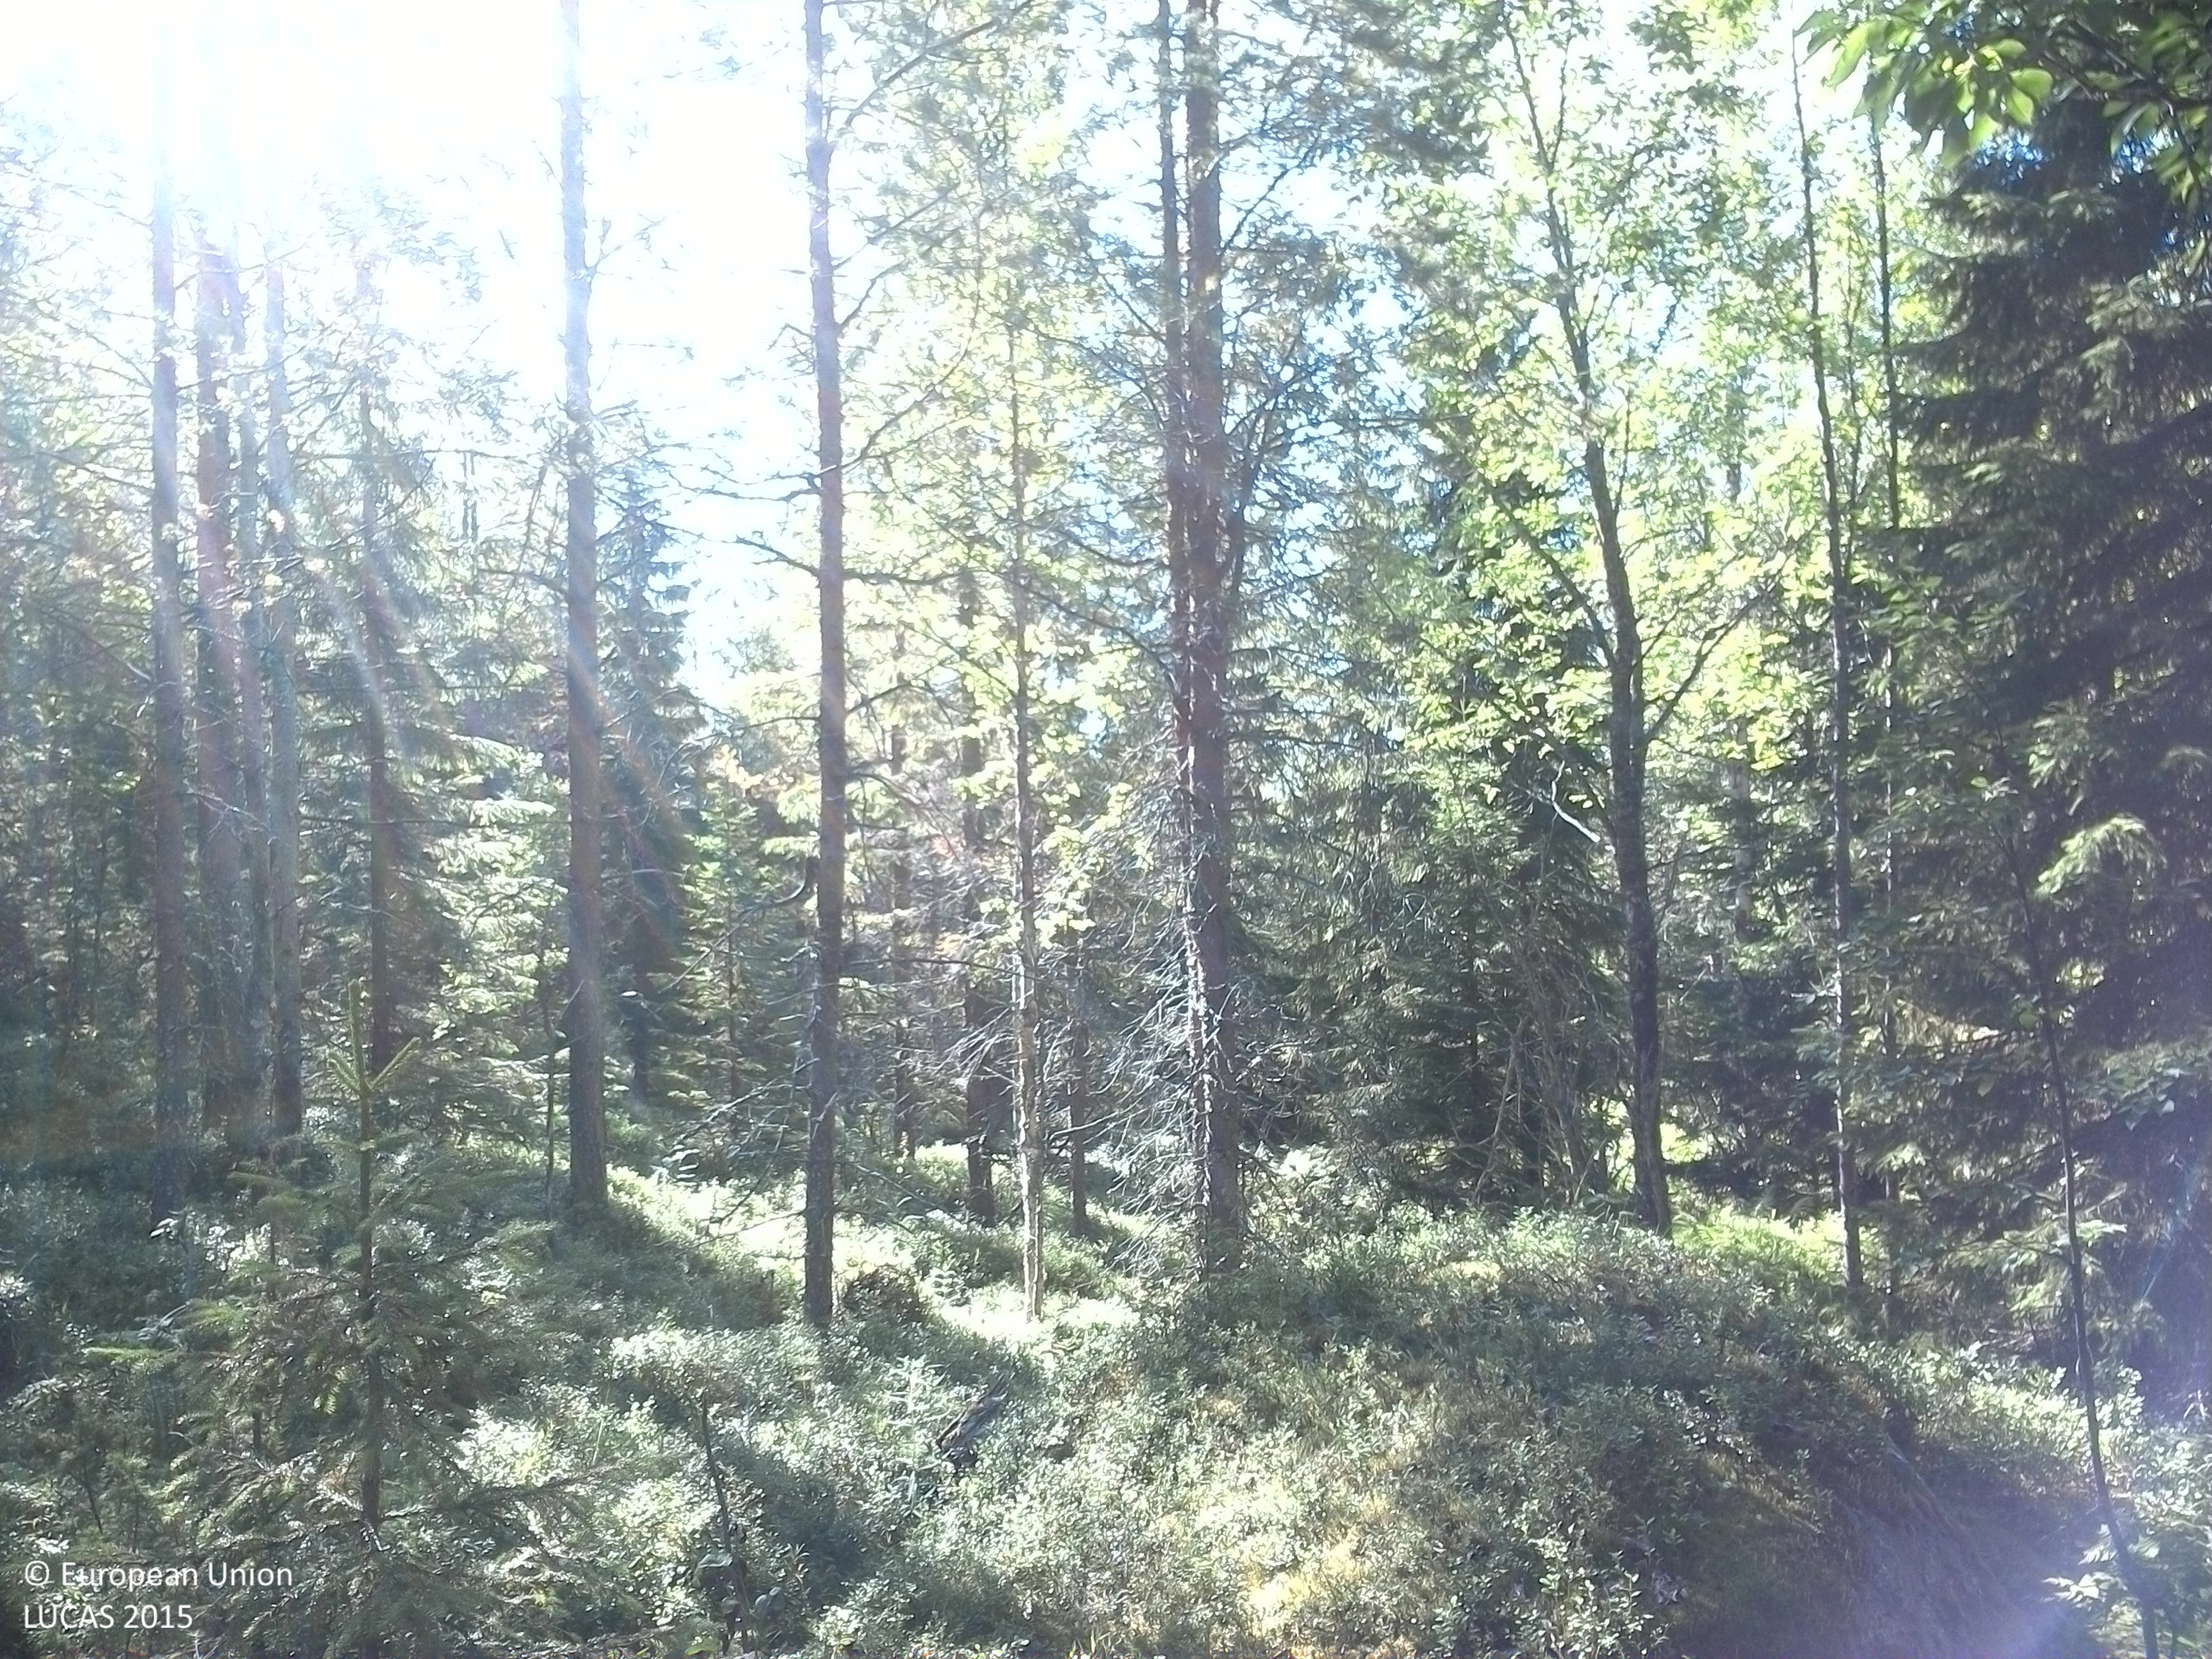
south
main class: Woodland
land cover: Pine dominated mixed woodland
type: boreal forest
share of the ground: 50 - 75 %
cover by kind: coniferous forest trees 35 %, shrubs 35 %, broadleaved forest trees 30 %
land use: Forestry
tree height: > 5 m
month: August
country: SE
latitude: 63.9068
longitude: 17.6131
